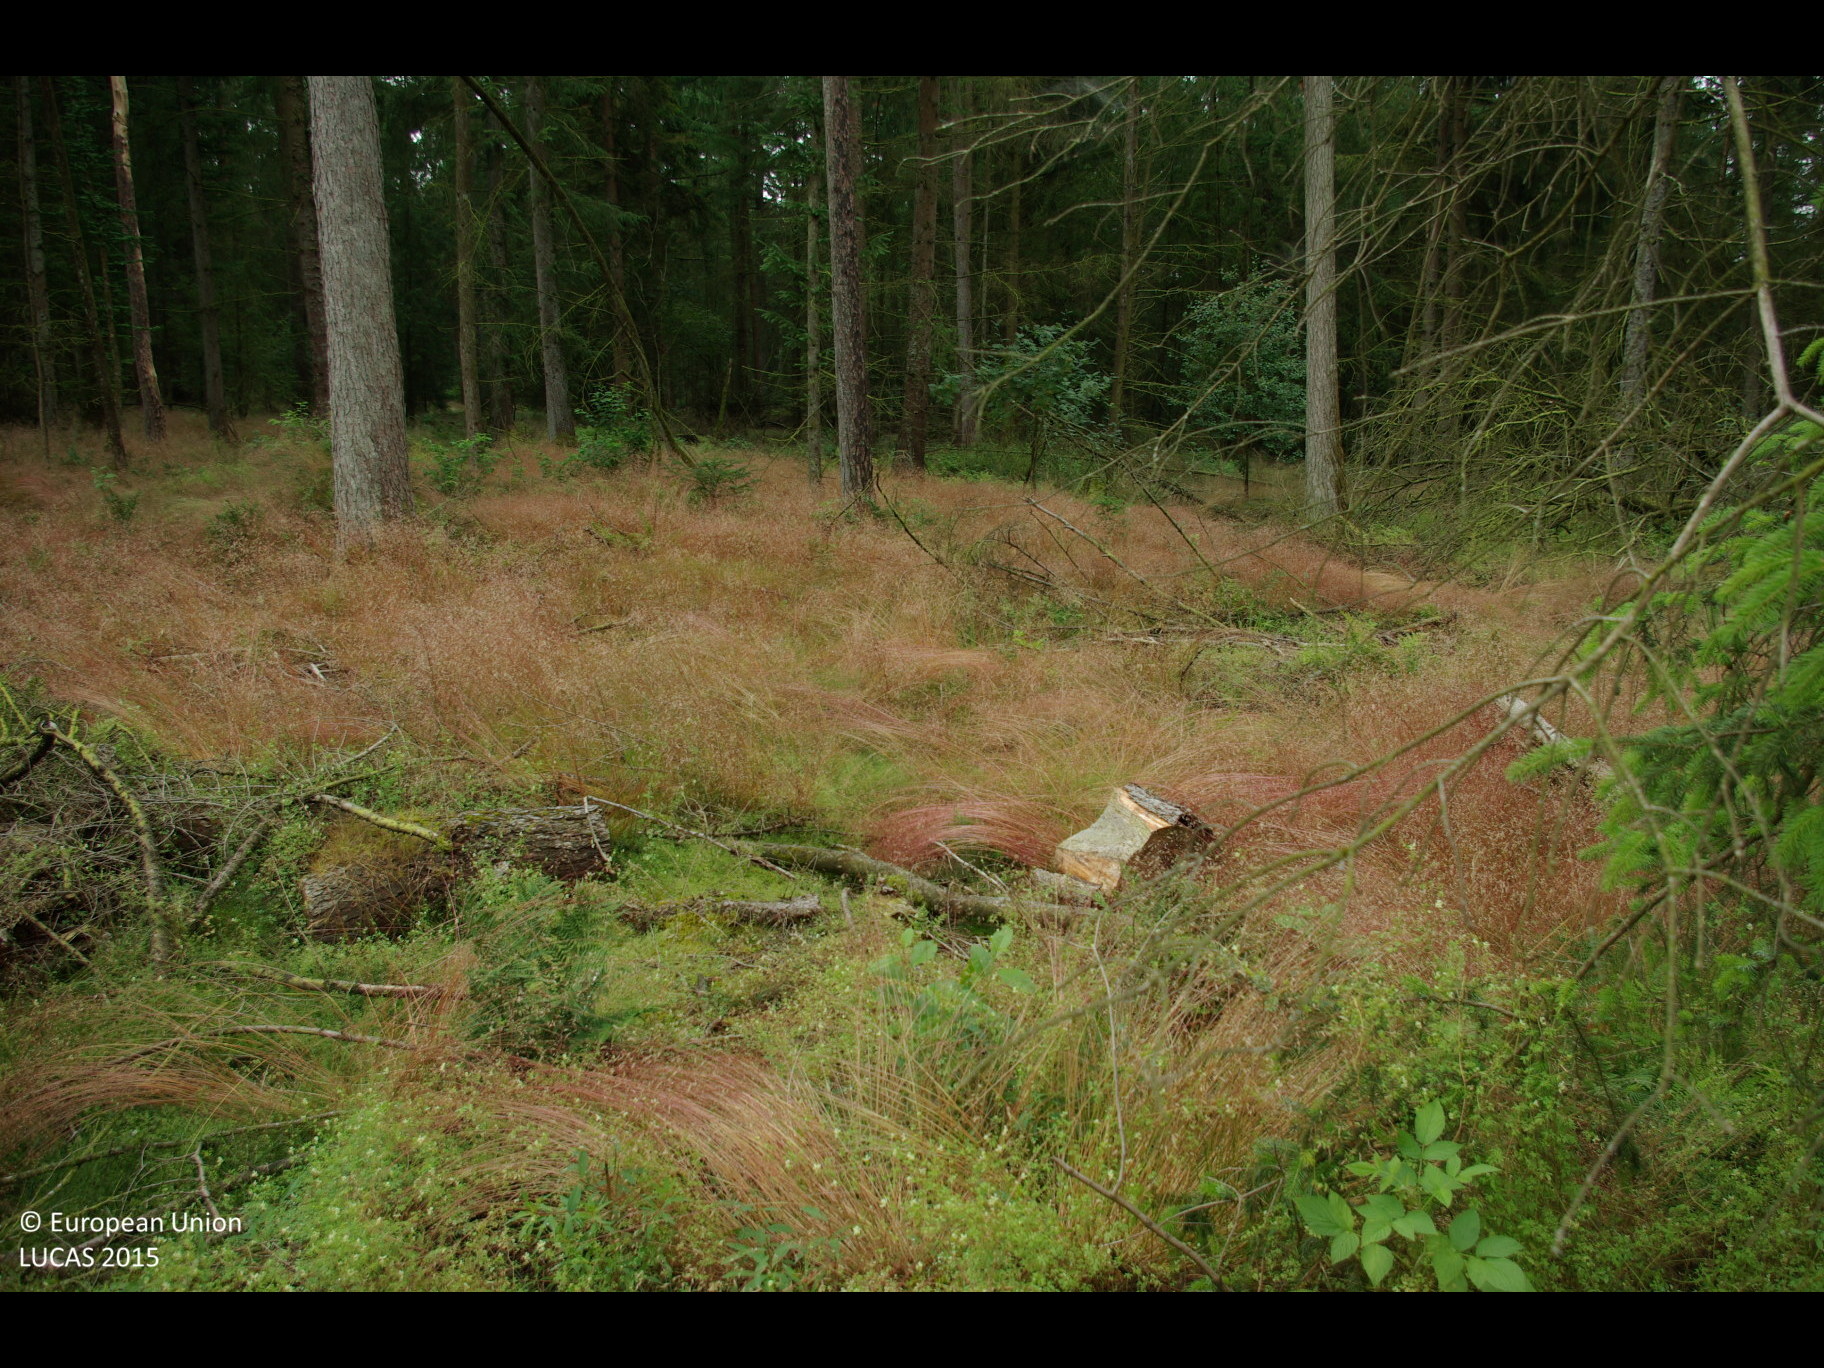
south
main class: Grassland
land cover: Grassland with sparse tree/shrub cover
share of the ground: > 75 %
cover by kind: herbaceous plants 95 %, coniferous forest trees 5 %
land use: Forestry
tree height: > 5 m
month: July
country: DE
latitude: 54.7655
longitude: 9.2390
